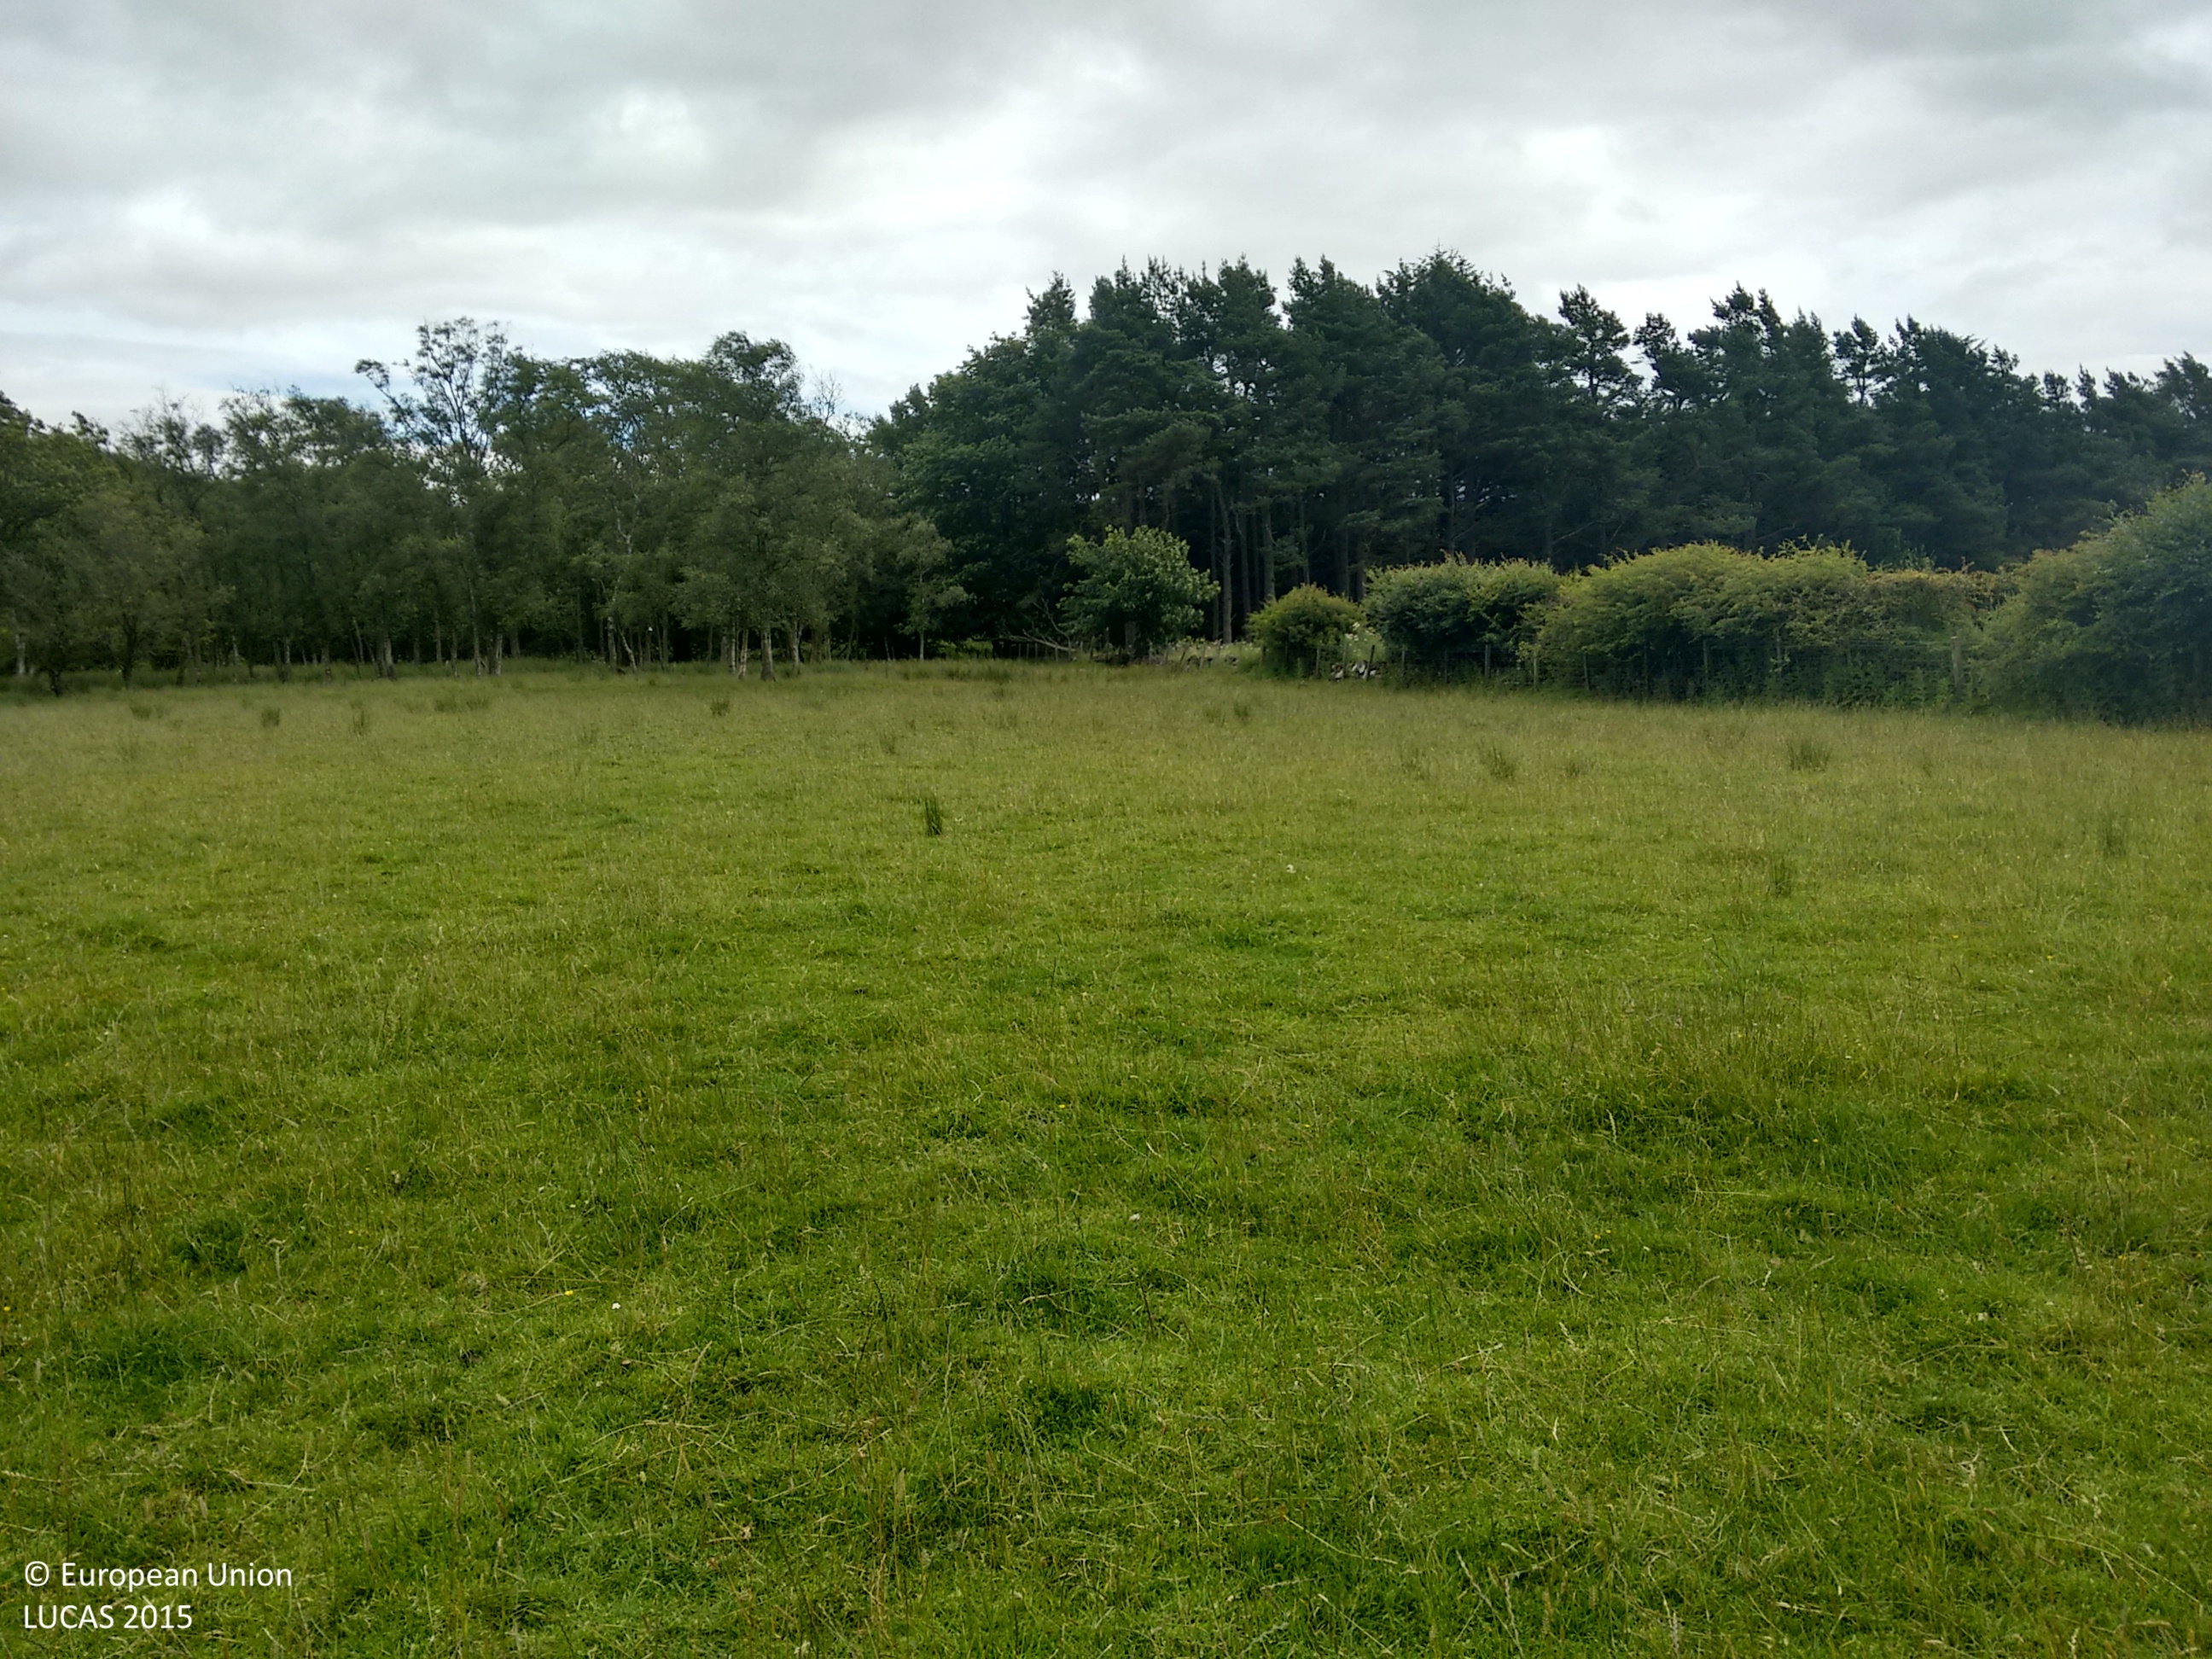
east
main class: Grassland
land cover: Grassland without tree/shrub cover
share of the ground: > 75 %
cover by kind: herbaceous plants 100 %
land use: Agriculture (excluding fallow land and kitchen gardens)
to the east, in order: Grassland without tree/shrub cover; Fences; Dry stone walls; Pine dominated mixed woodland; Ditches and canals; Grass margins; Paved roads, cycling and walking lanes; Grass margins; Dry stone walls; Fences; Grassland without tree/shrub cover; Spruce dominated mixed woodland; Grassland without tree/shrub cover
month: August
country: GB
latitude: 56.2625
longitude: -2.8999
